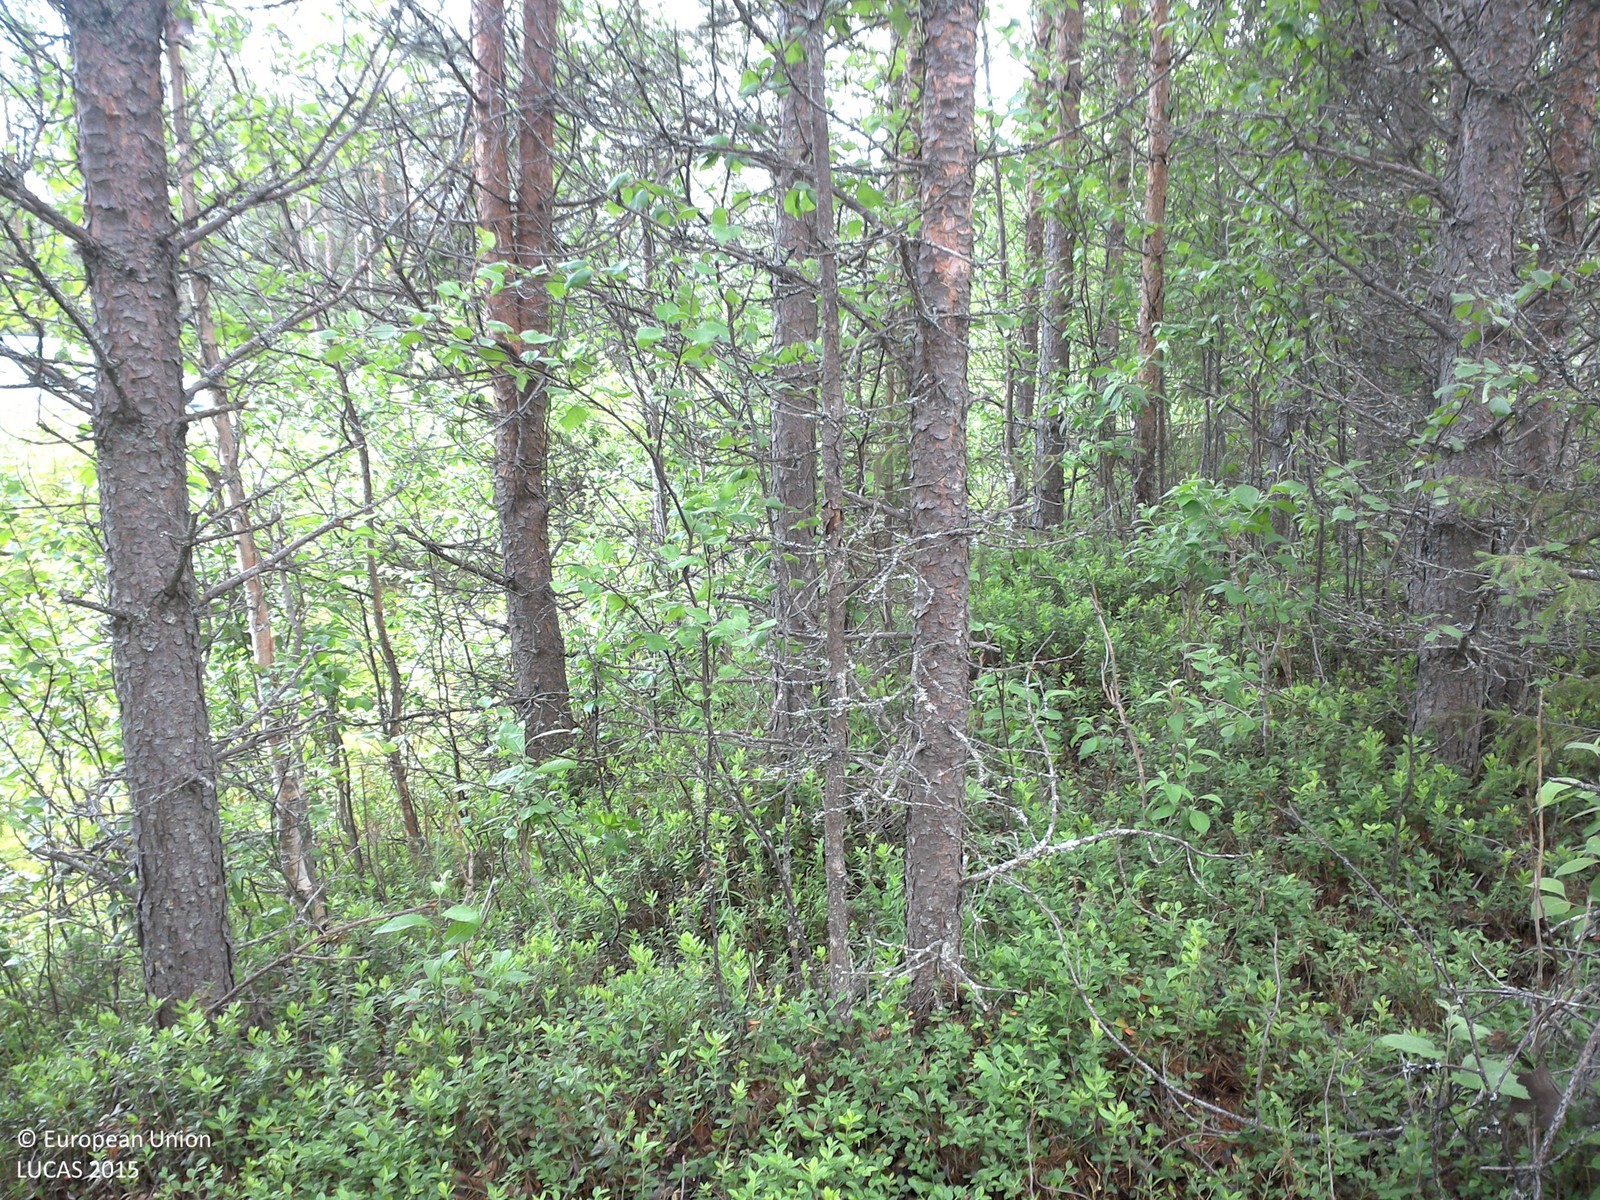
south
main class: Woodland
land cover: Pine dominated mixed woodland
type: boreal forest
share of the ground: 25 - 50 %
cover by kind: shrubs 60 %, coniferous forest trees 25 %, broadleaved forest trees 10 %, lichens and mosses 5 %
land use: Forestry
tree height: > 5 m
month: July
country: SE
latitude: 66.8554
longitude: 23.7300
